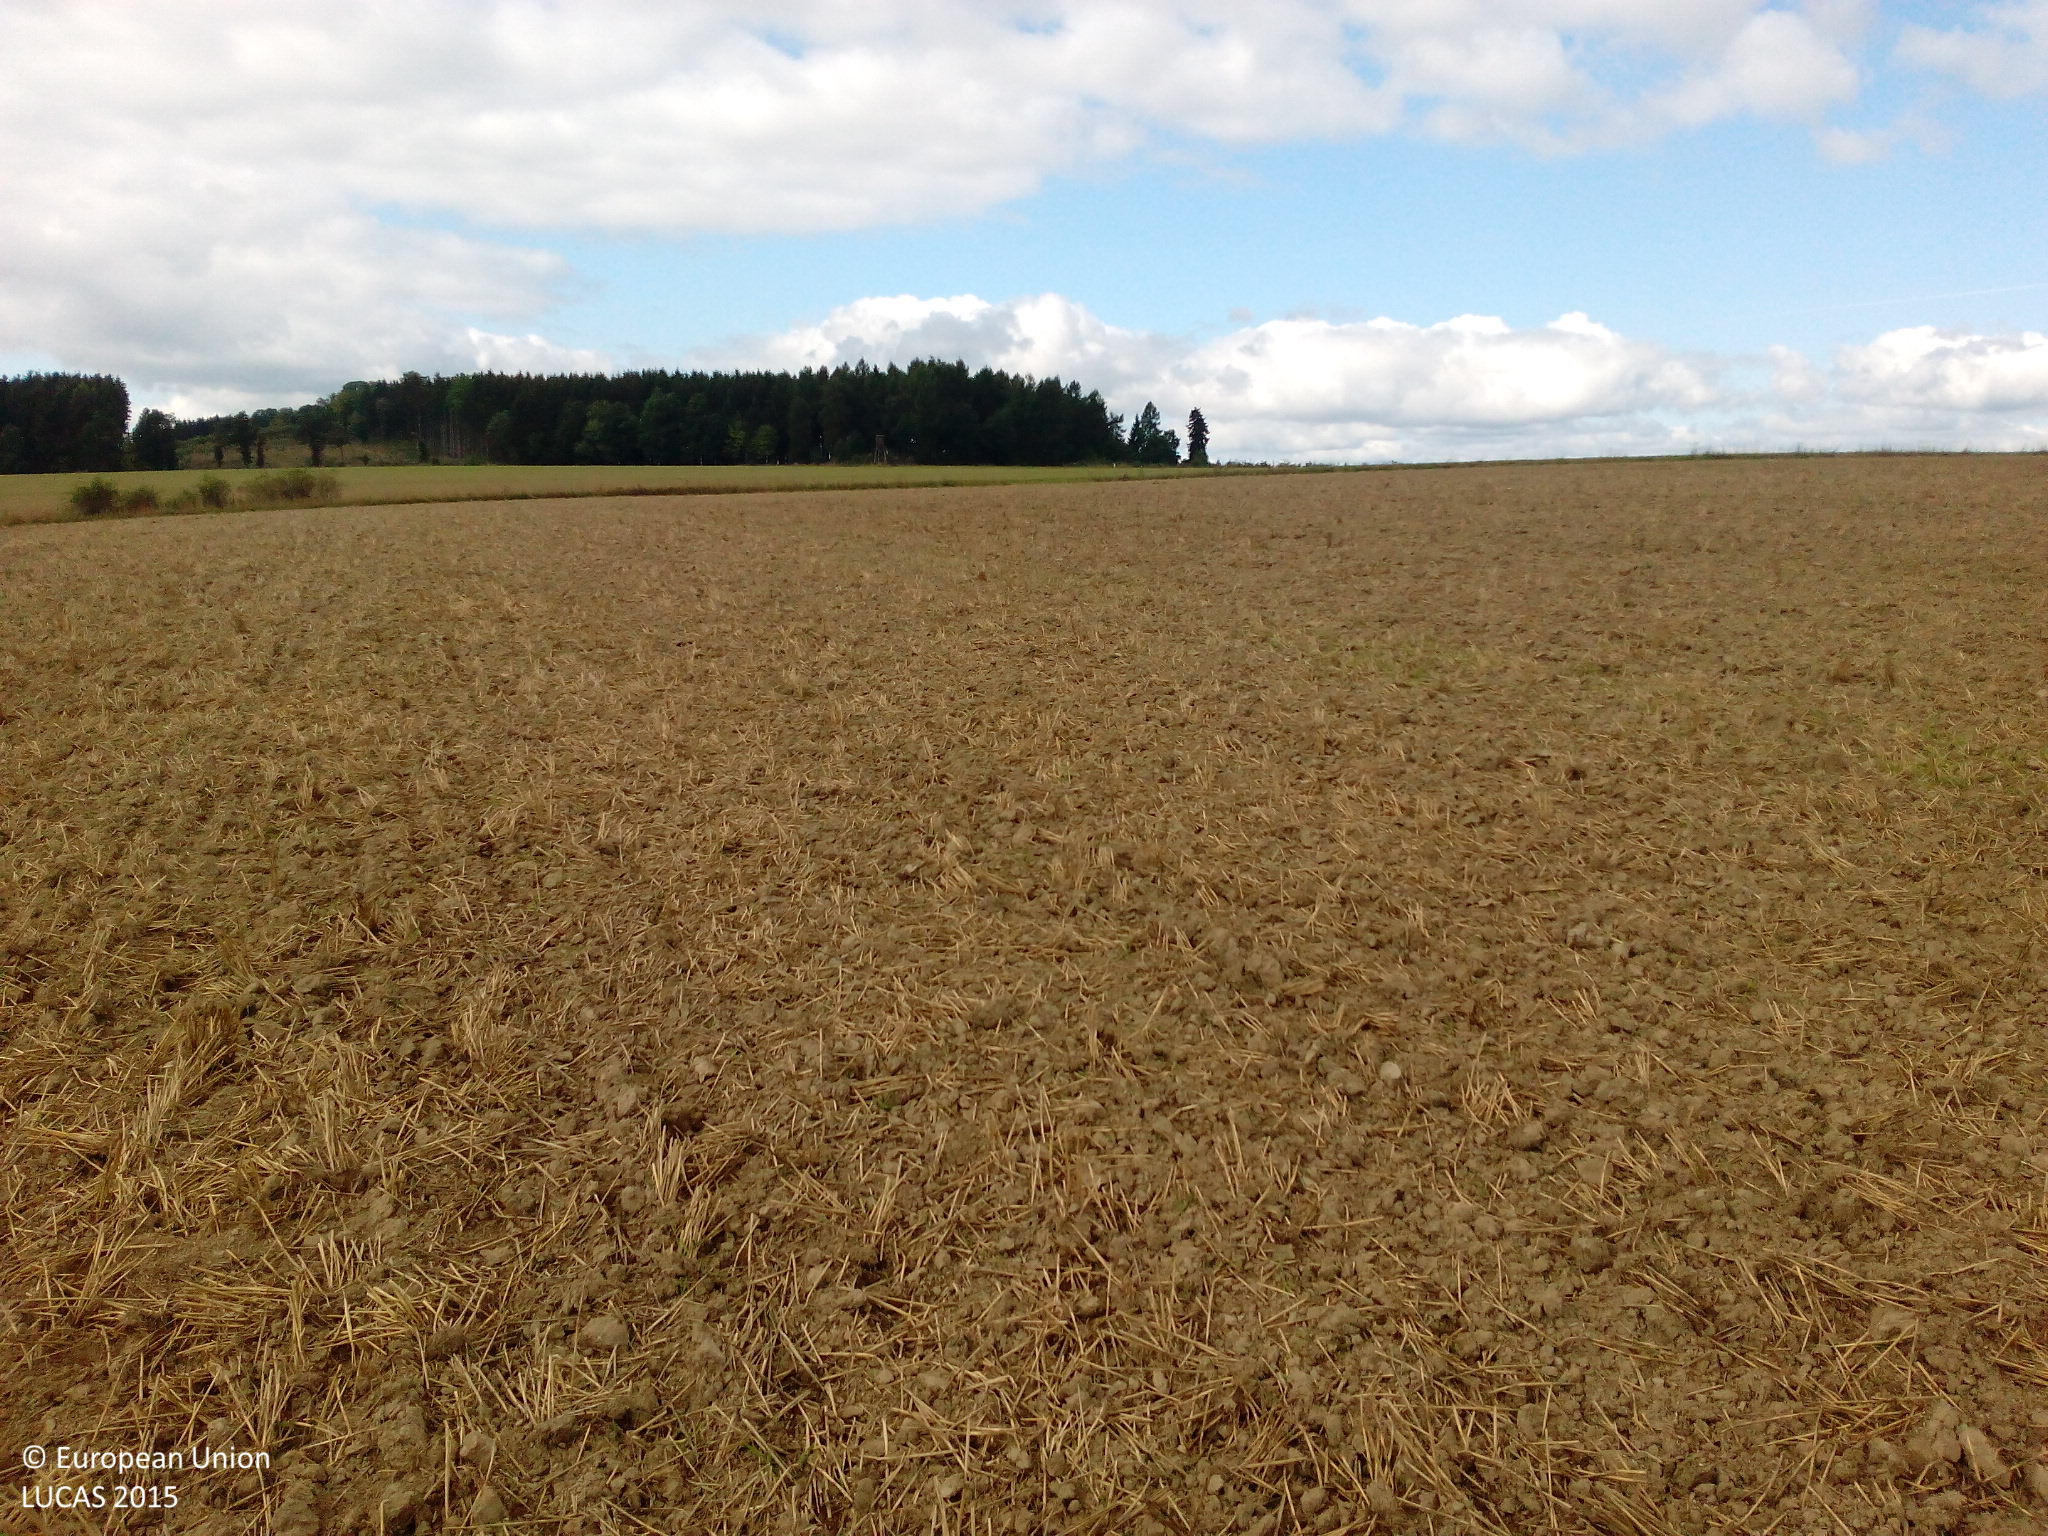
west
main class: Cropland
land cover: Common wheat
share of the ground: < 10 %
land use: Agriculture (excluding fallow land and kitchen gardens)
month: September
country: DE
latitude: 51.6540
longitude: 11.0260
